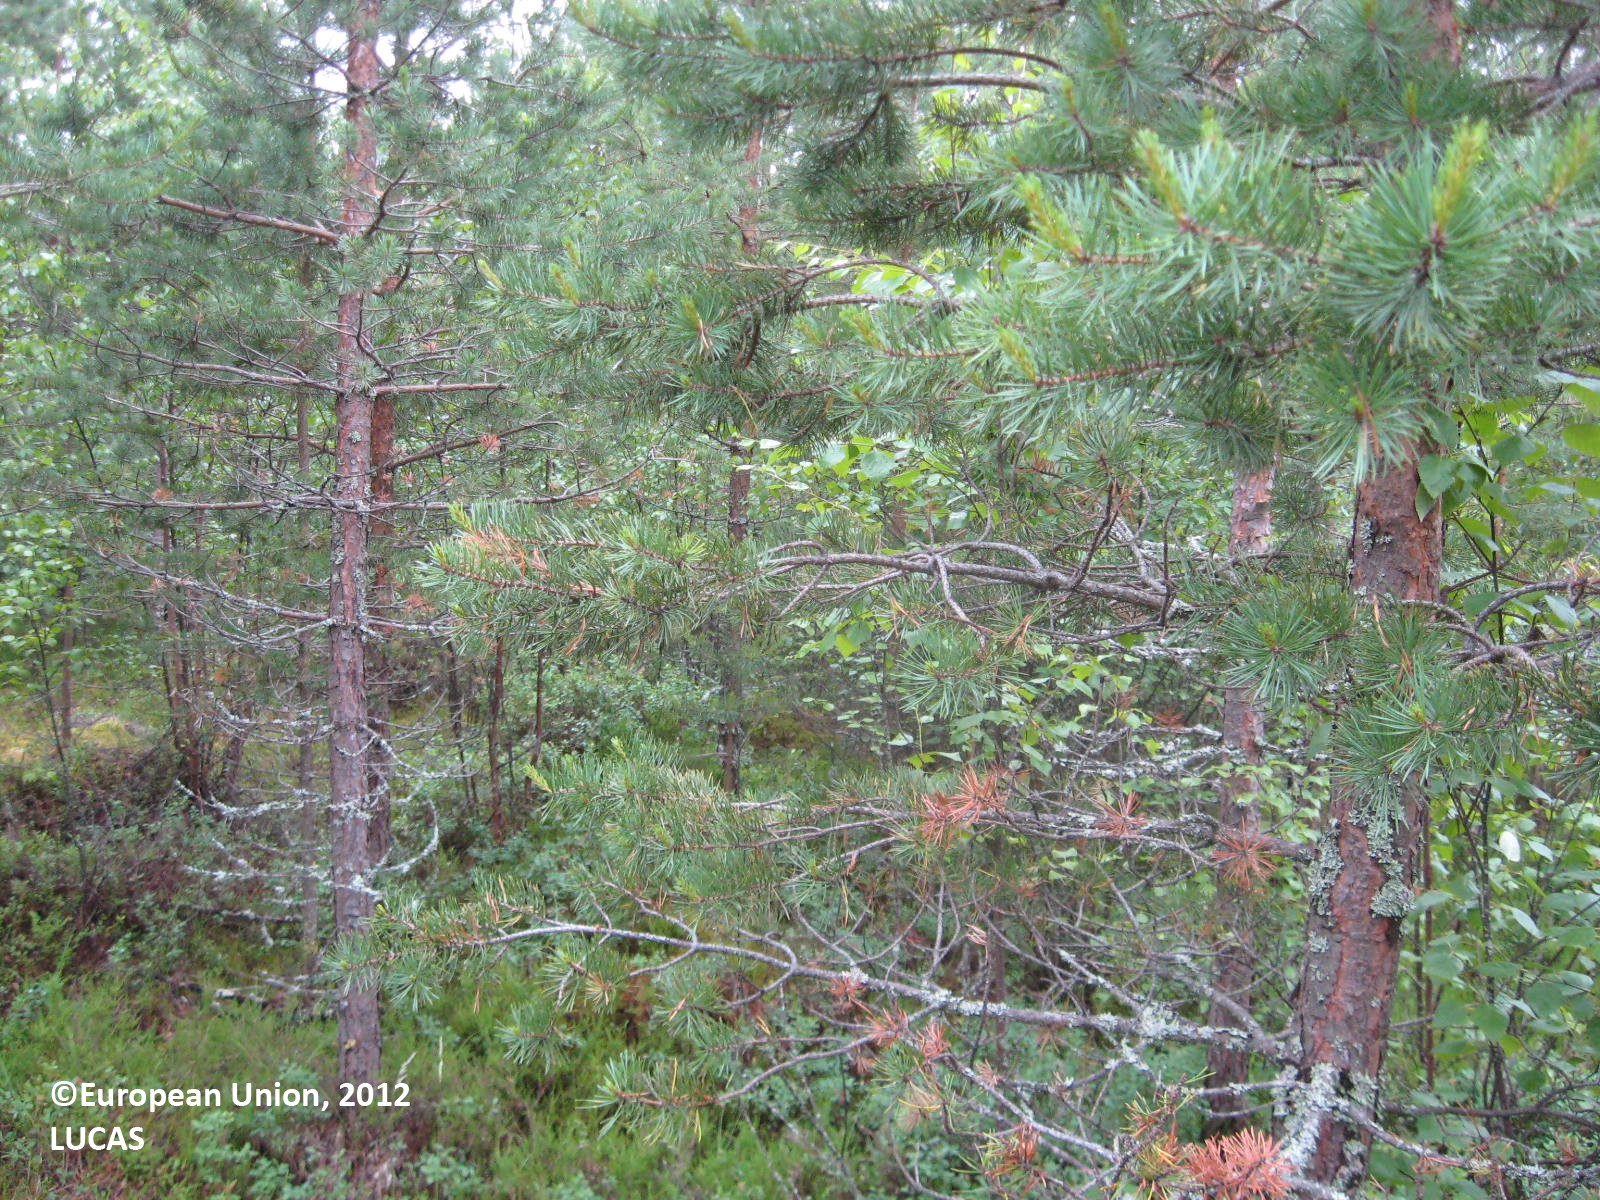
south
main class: Woodland
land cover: Pine dominated coniferous woodland
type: boreal forest
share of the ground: > 75 %
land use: Forestry
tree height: < 5 m
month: July
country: FI
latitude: 62.3763
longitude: 22.5658
